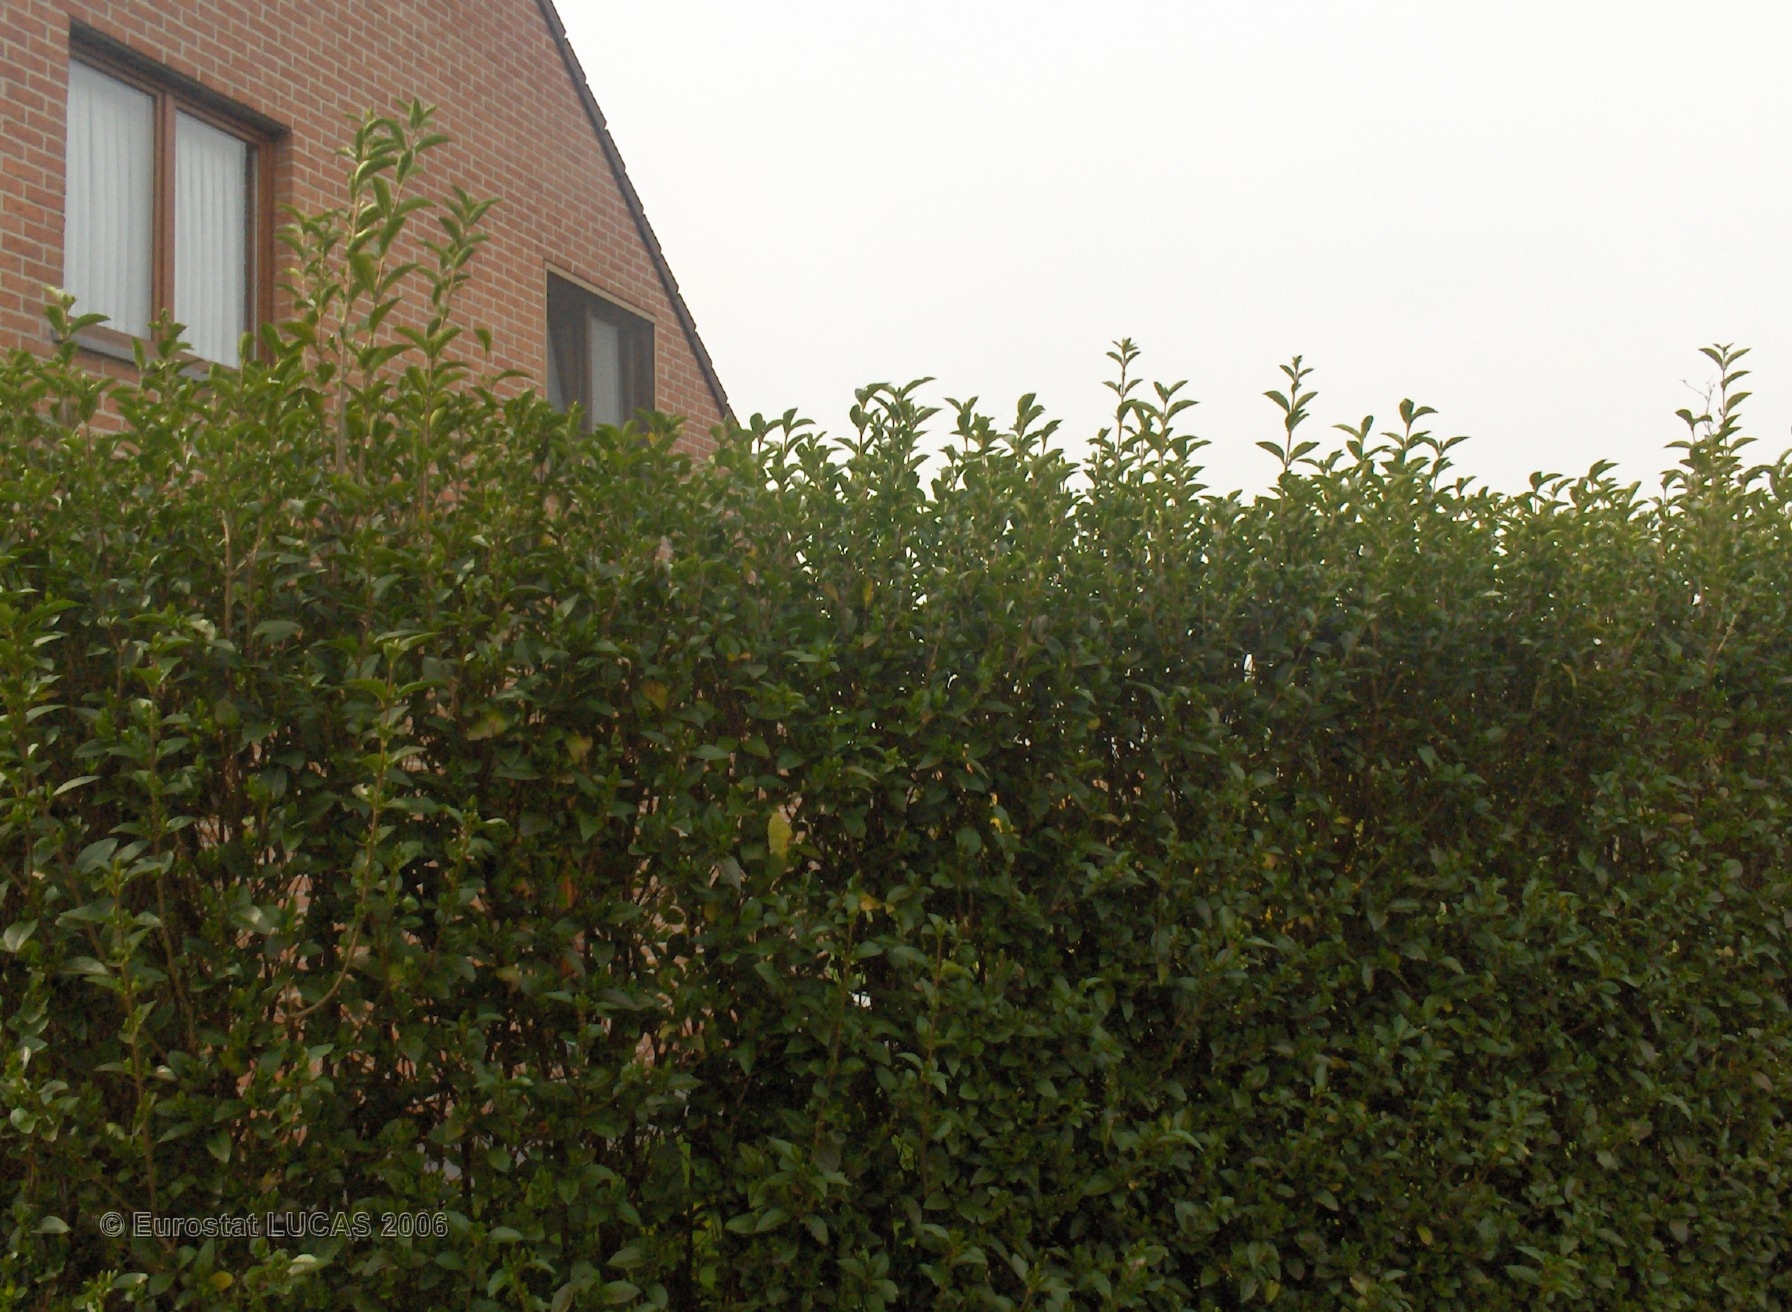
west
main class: Grassland
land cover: Grassland with sparse tree/shrub cover
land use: Residential
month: April
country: BE
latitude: 50.8709
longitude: 3.6123
